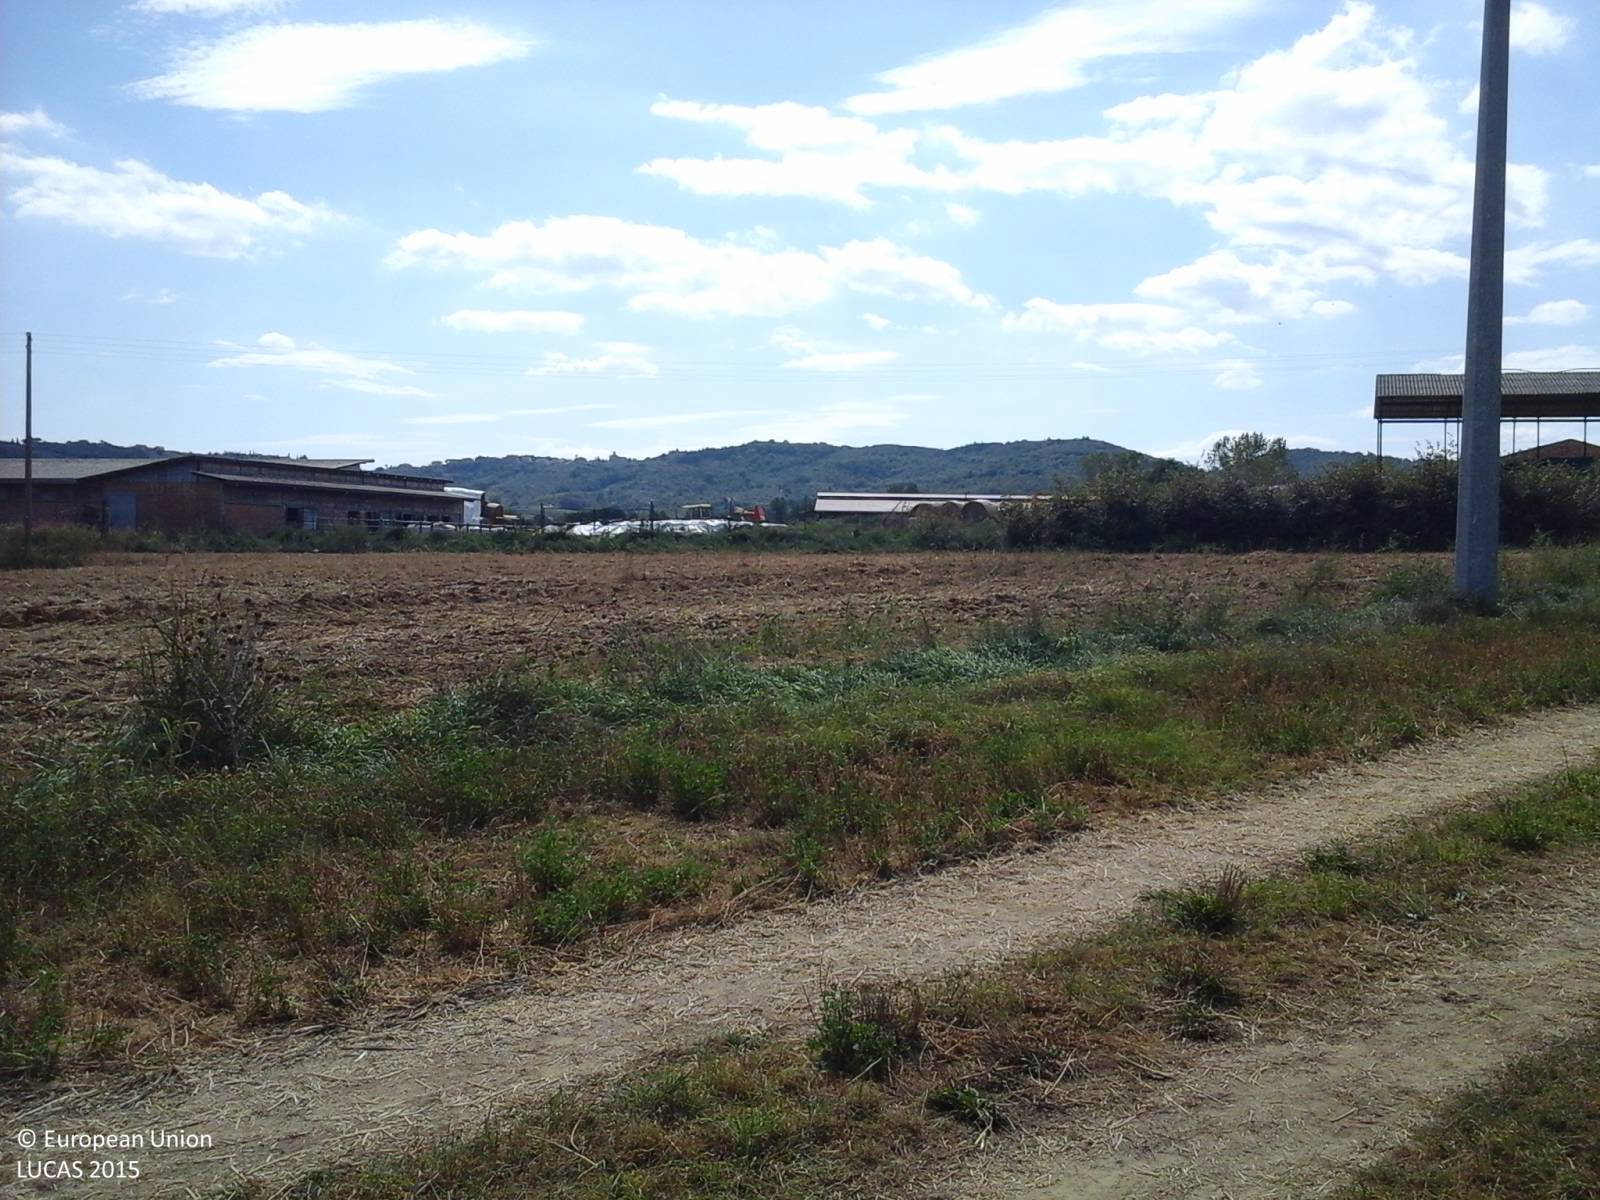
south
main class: Grassland
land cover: Grassland without tree/shrub cover
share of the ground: 50 - 75 %
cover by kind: herbaceous plants 100 %
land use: Agriculture (excluding fallow land and kitchen gardens)
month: September
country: IT
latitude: 43.0989
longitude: 12.2419
